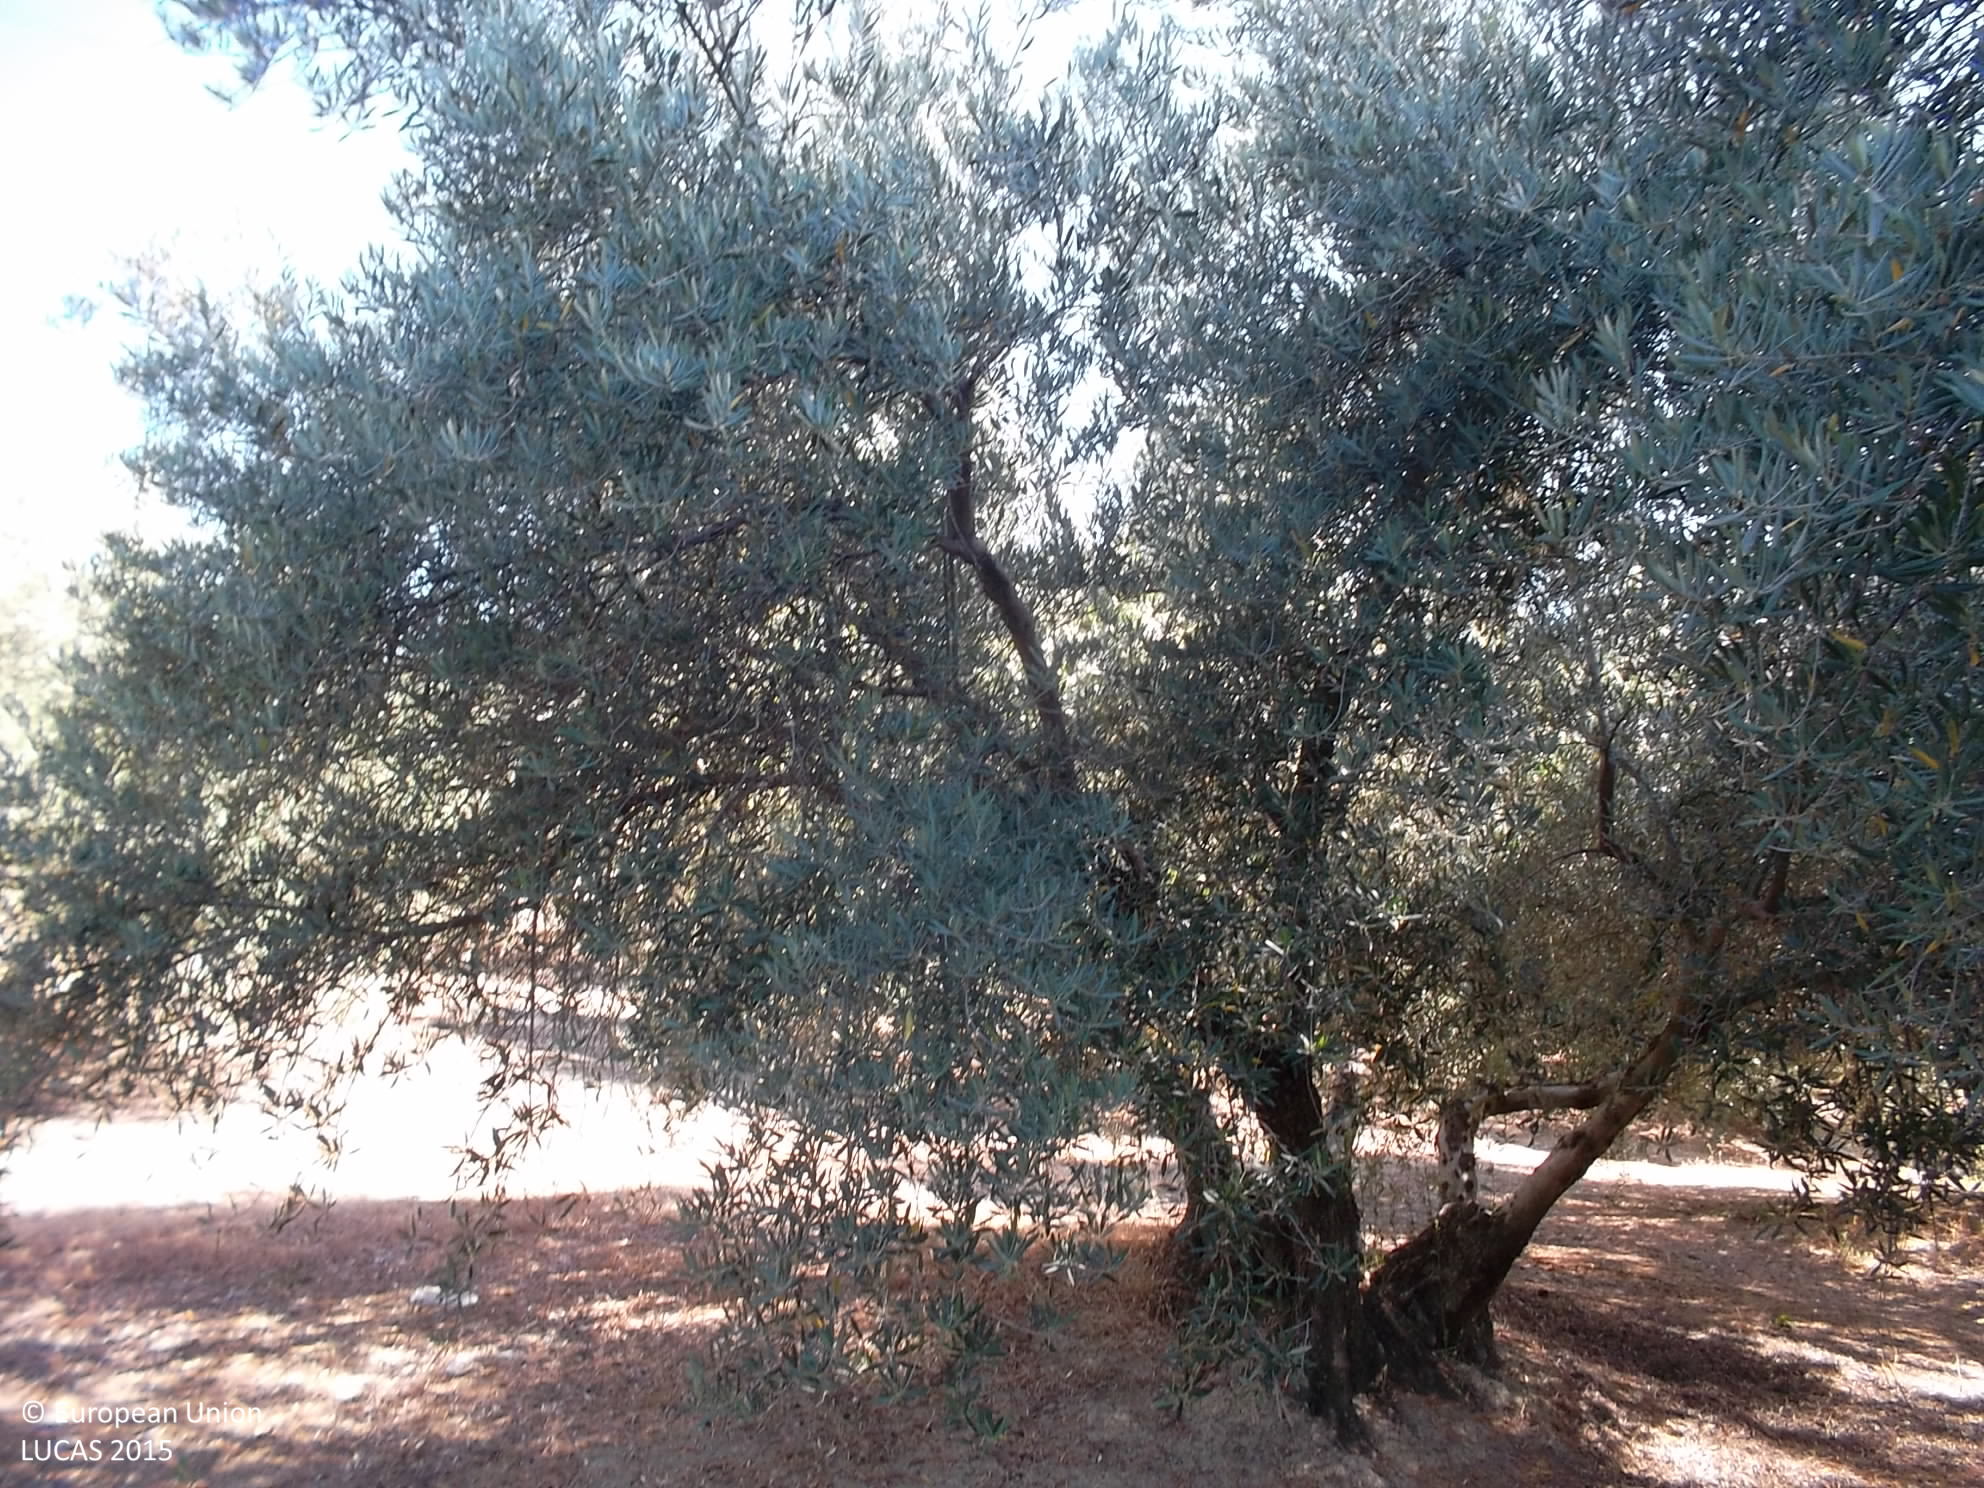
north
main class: Cropland
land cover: Olive groves
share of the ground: 25 - 50 %
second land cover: Other bare soil
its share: > 75 %
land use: Agriculture (excluding fallow land and kitchen gardens)
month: June
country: ES
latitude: 37.8524
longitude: -3.0533
